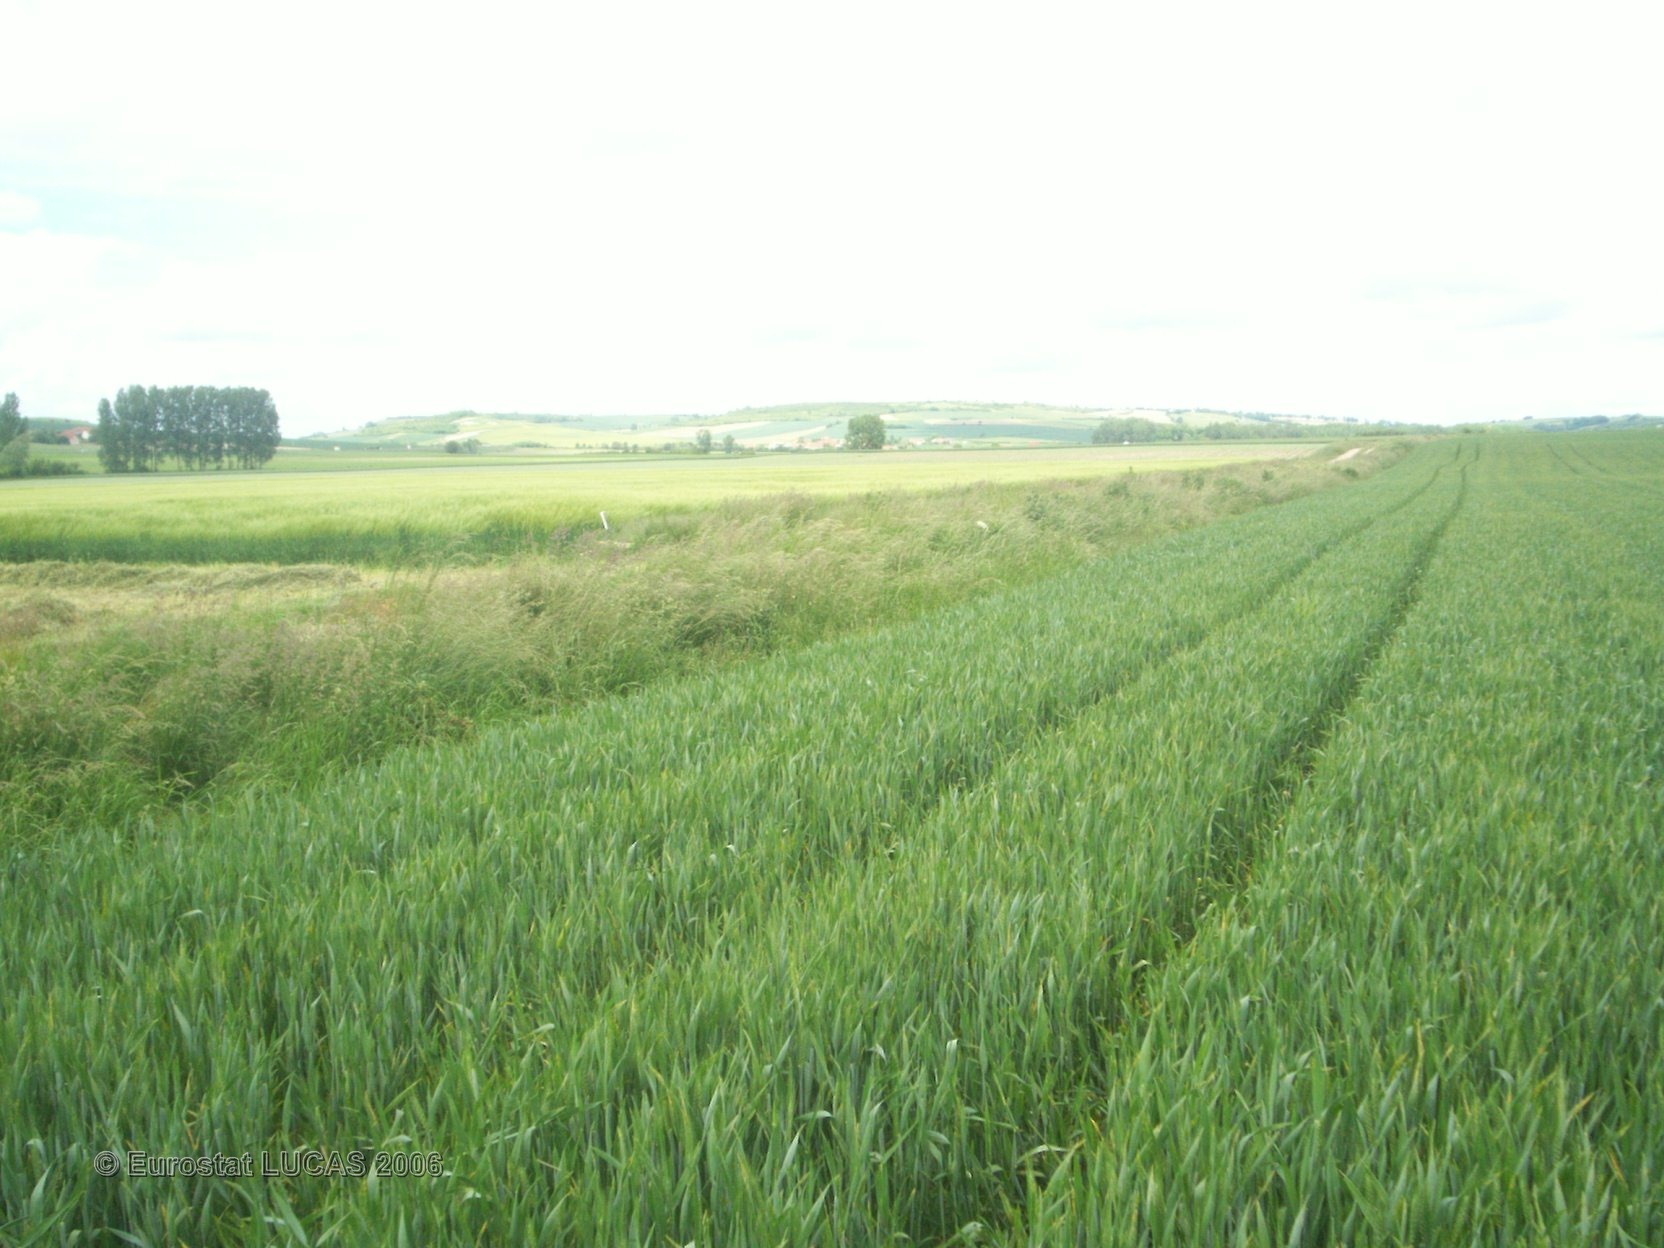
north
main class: Cropland
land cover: Common wheat
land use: Agriculture (excluding fallow land and kitchen gardens)
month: May
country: FR
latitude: 46.1479
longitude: 3.1238
